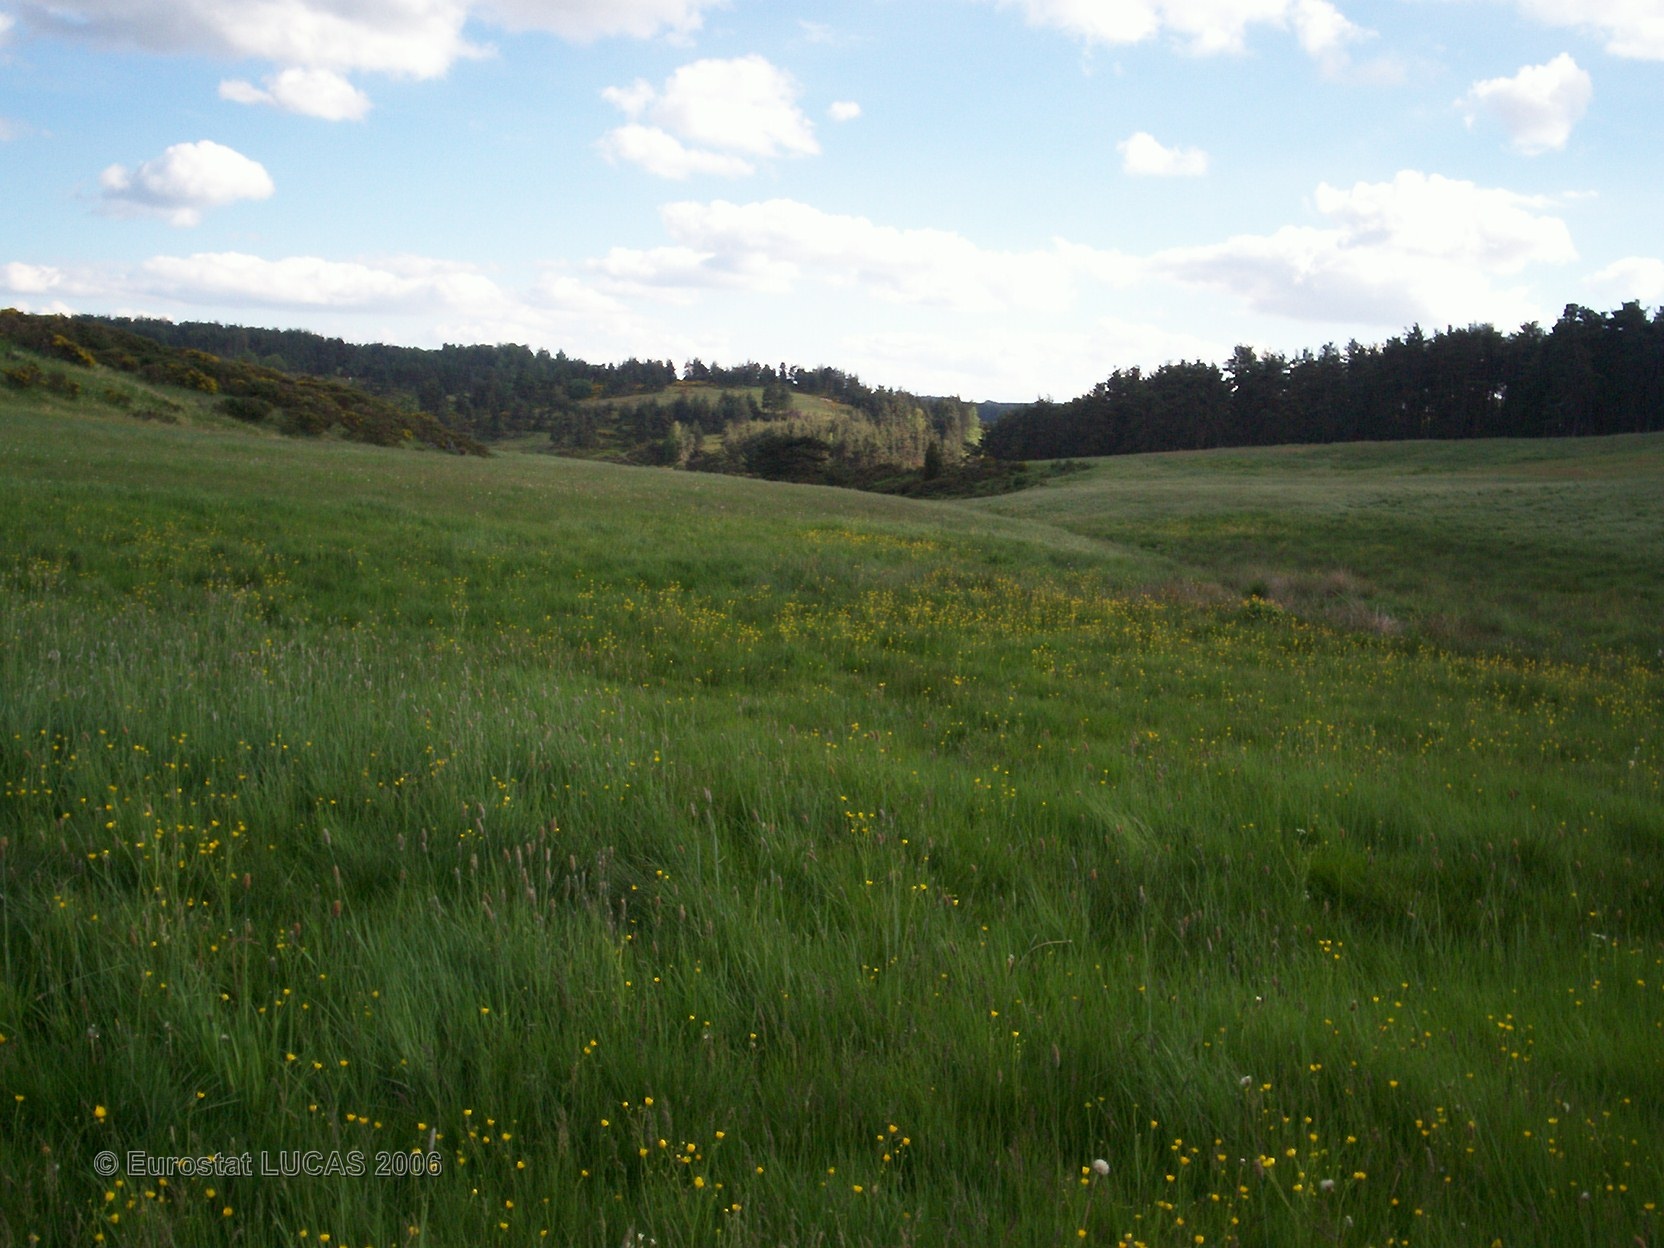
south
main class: Grassland
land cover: Grassland without tree/shrub cover
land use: Agriculture (excluding fallow land and kitchen gardens)
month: May
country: FR
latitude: 44.7013
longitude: 3.4038
